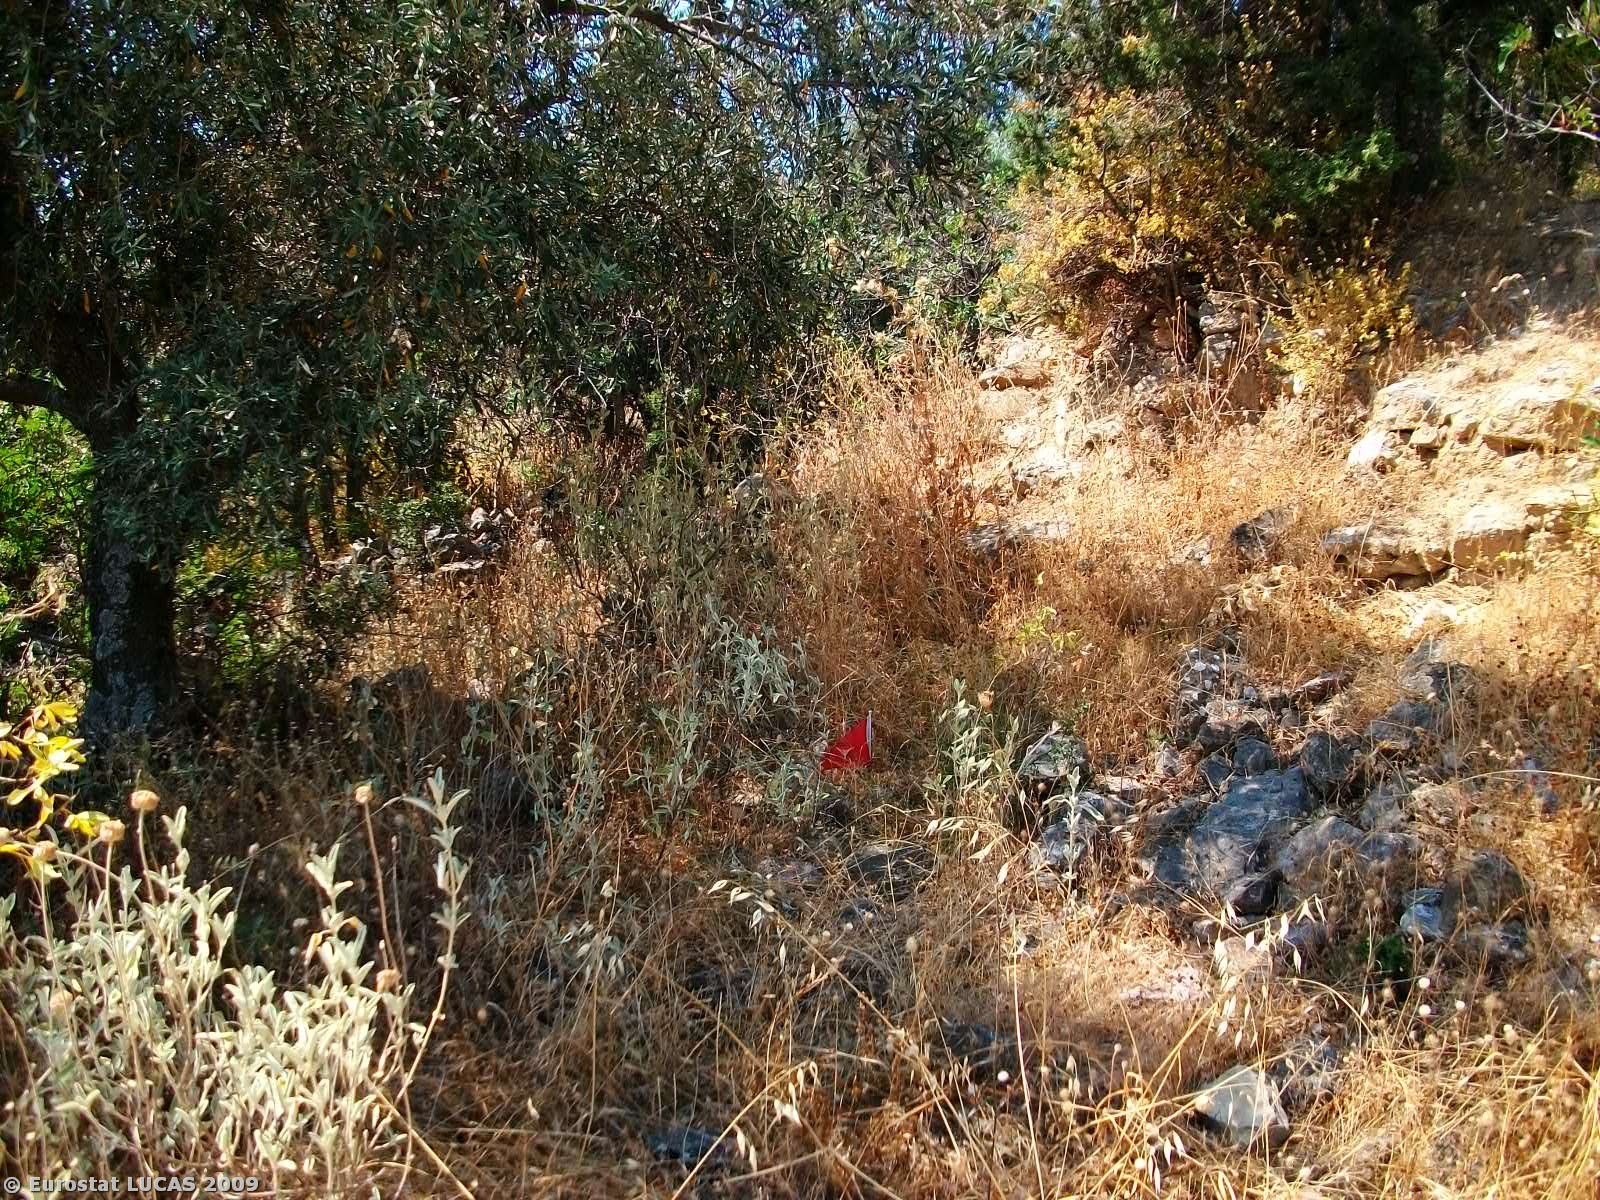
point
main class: Shrubland
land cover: Shrubland with sparse tree cover
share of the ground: 50 - 75 %
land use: Unused
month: July
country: GR
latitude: 38.3655
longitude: 22.3683
